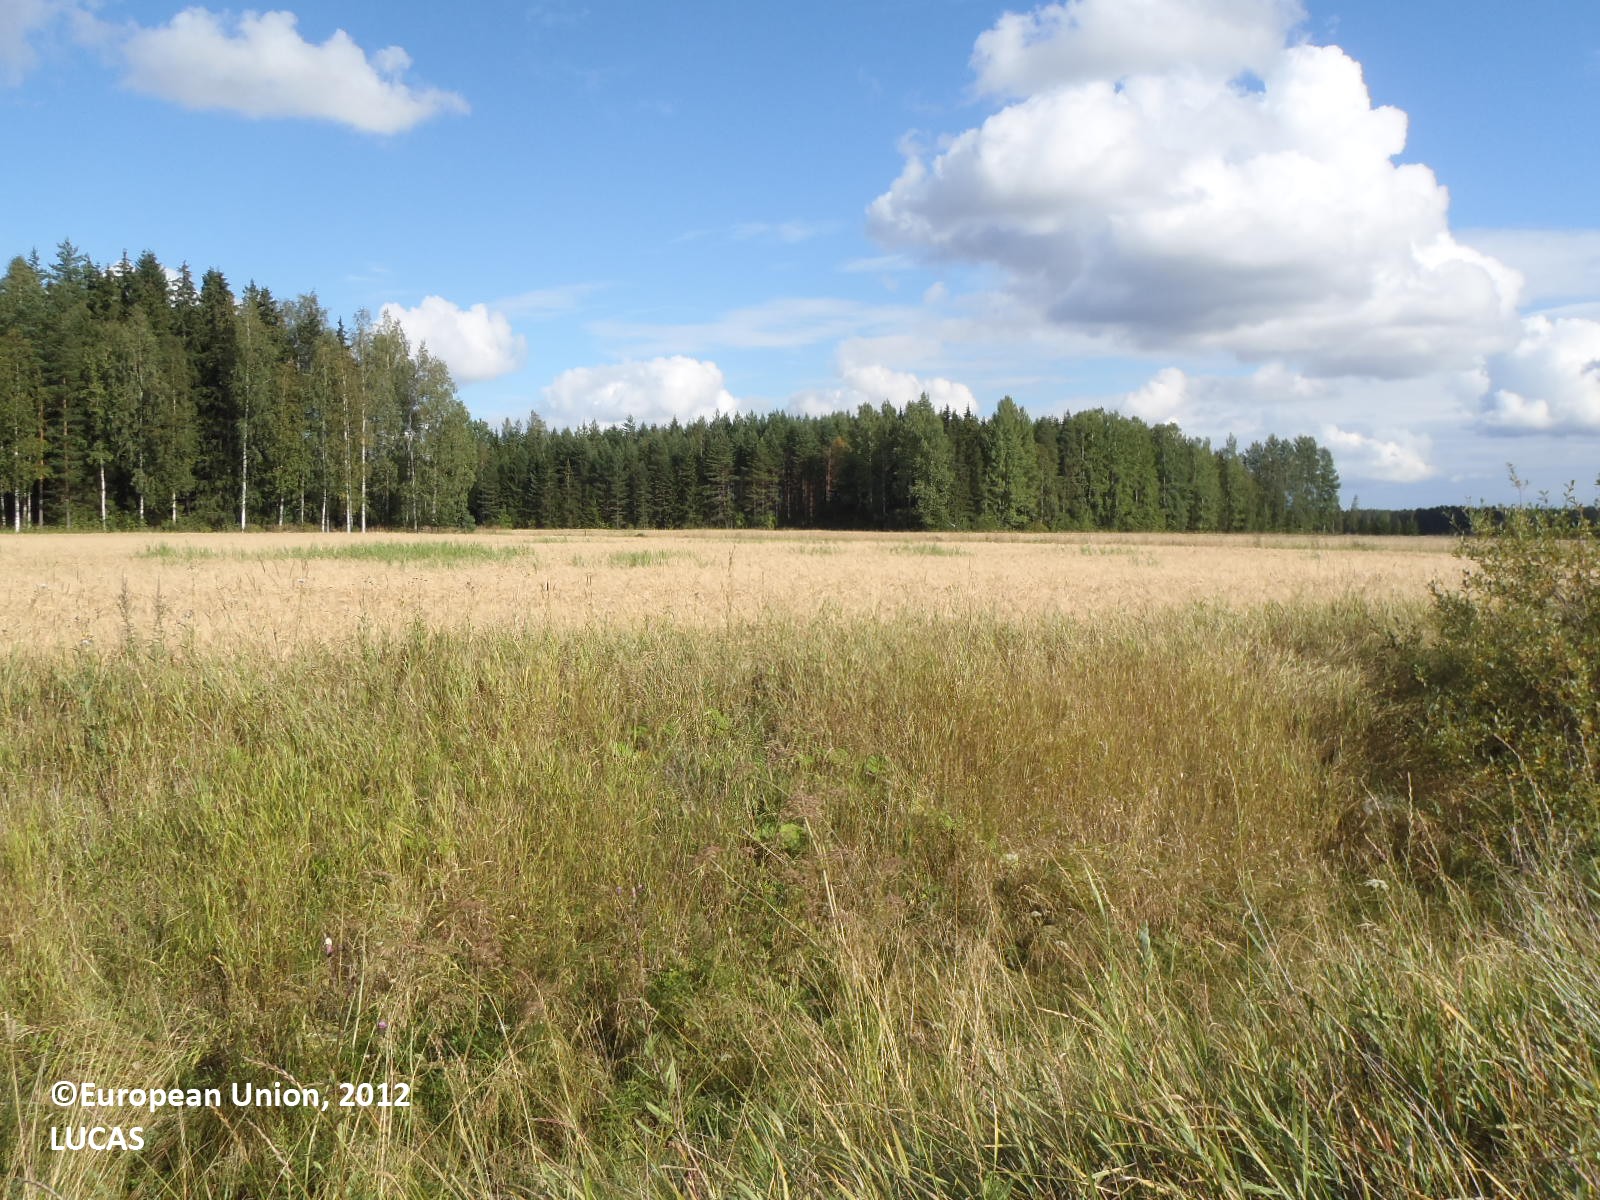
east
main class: Cropland
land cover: Barley
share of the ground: > 75 %
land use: Agriculture (excluding fallow land and kitchen gardens)
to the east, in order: Barley; Grass margins; Ditches and canals; Grass margins; Single bushes/trees; Barley; Grass margins; Ditches and canals; Grass margins; Barley; Grass margins; Ditches and canals; Pine dominated coniferous woodland
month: August
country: FI
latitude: 60.6621
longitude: 22.7156
